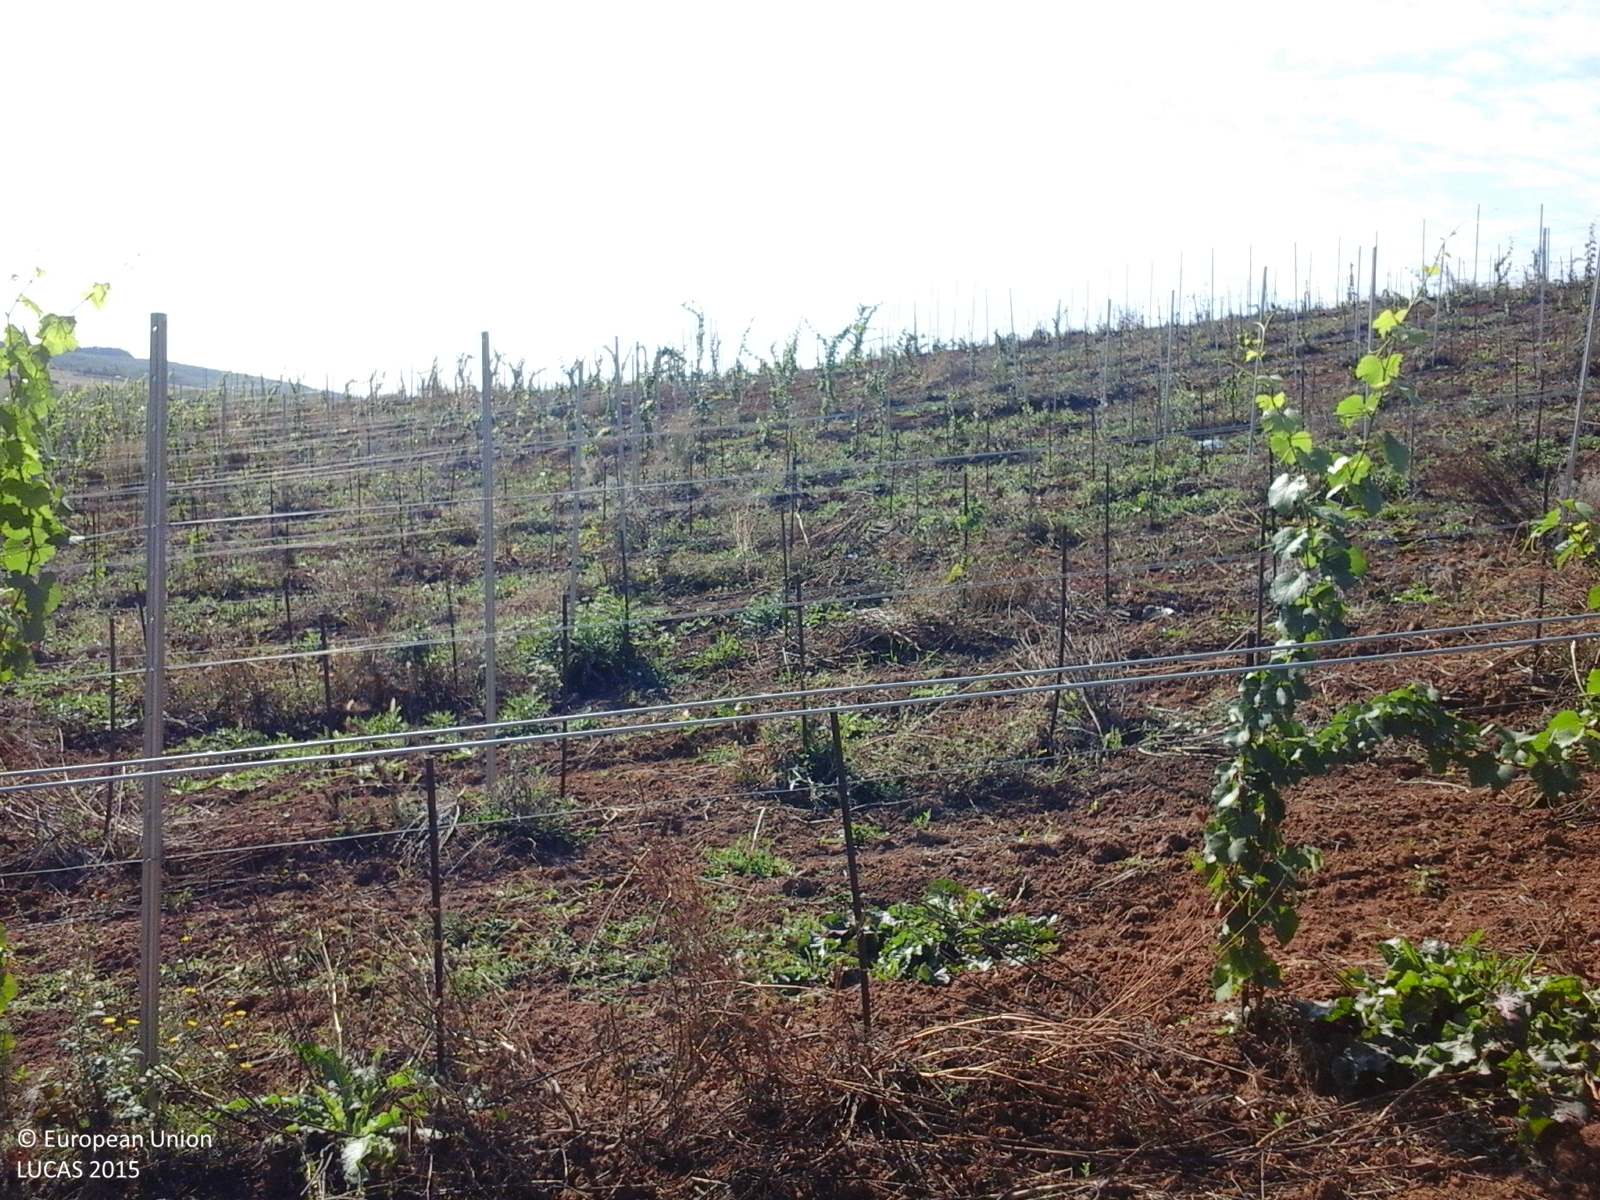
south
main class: Cropland
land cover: Vineyards
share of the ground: 10 - 25 %
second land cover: Other bare soil
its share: > 75 %
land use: Agriculture (excluding fallow land and kitchen gardens)
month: September
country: RO
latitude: 47.4868
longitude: 22.8432
